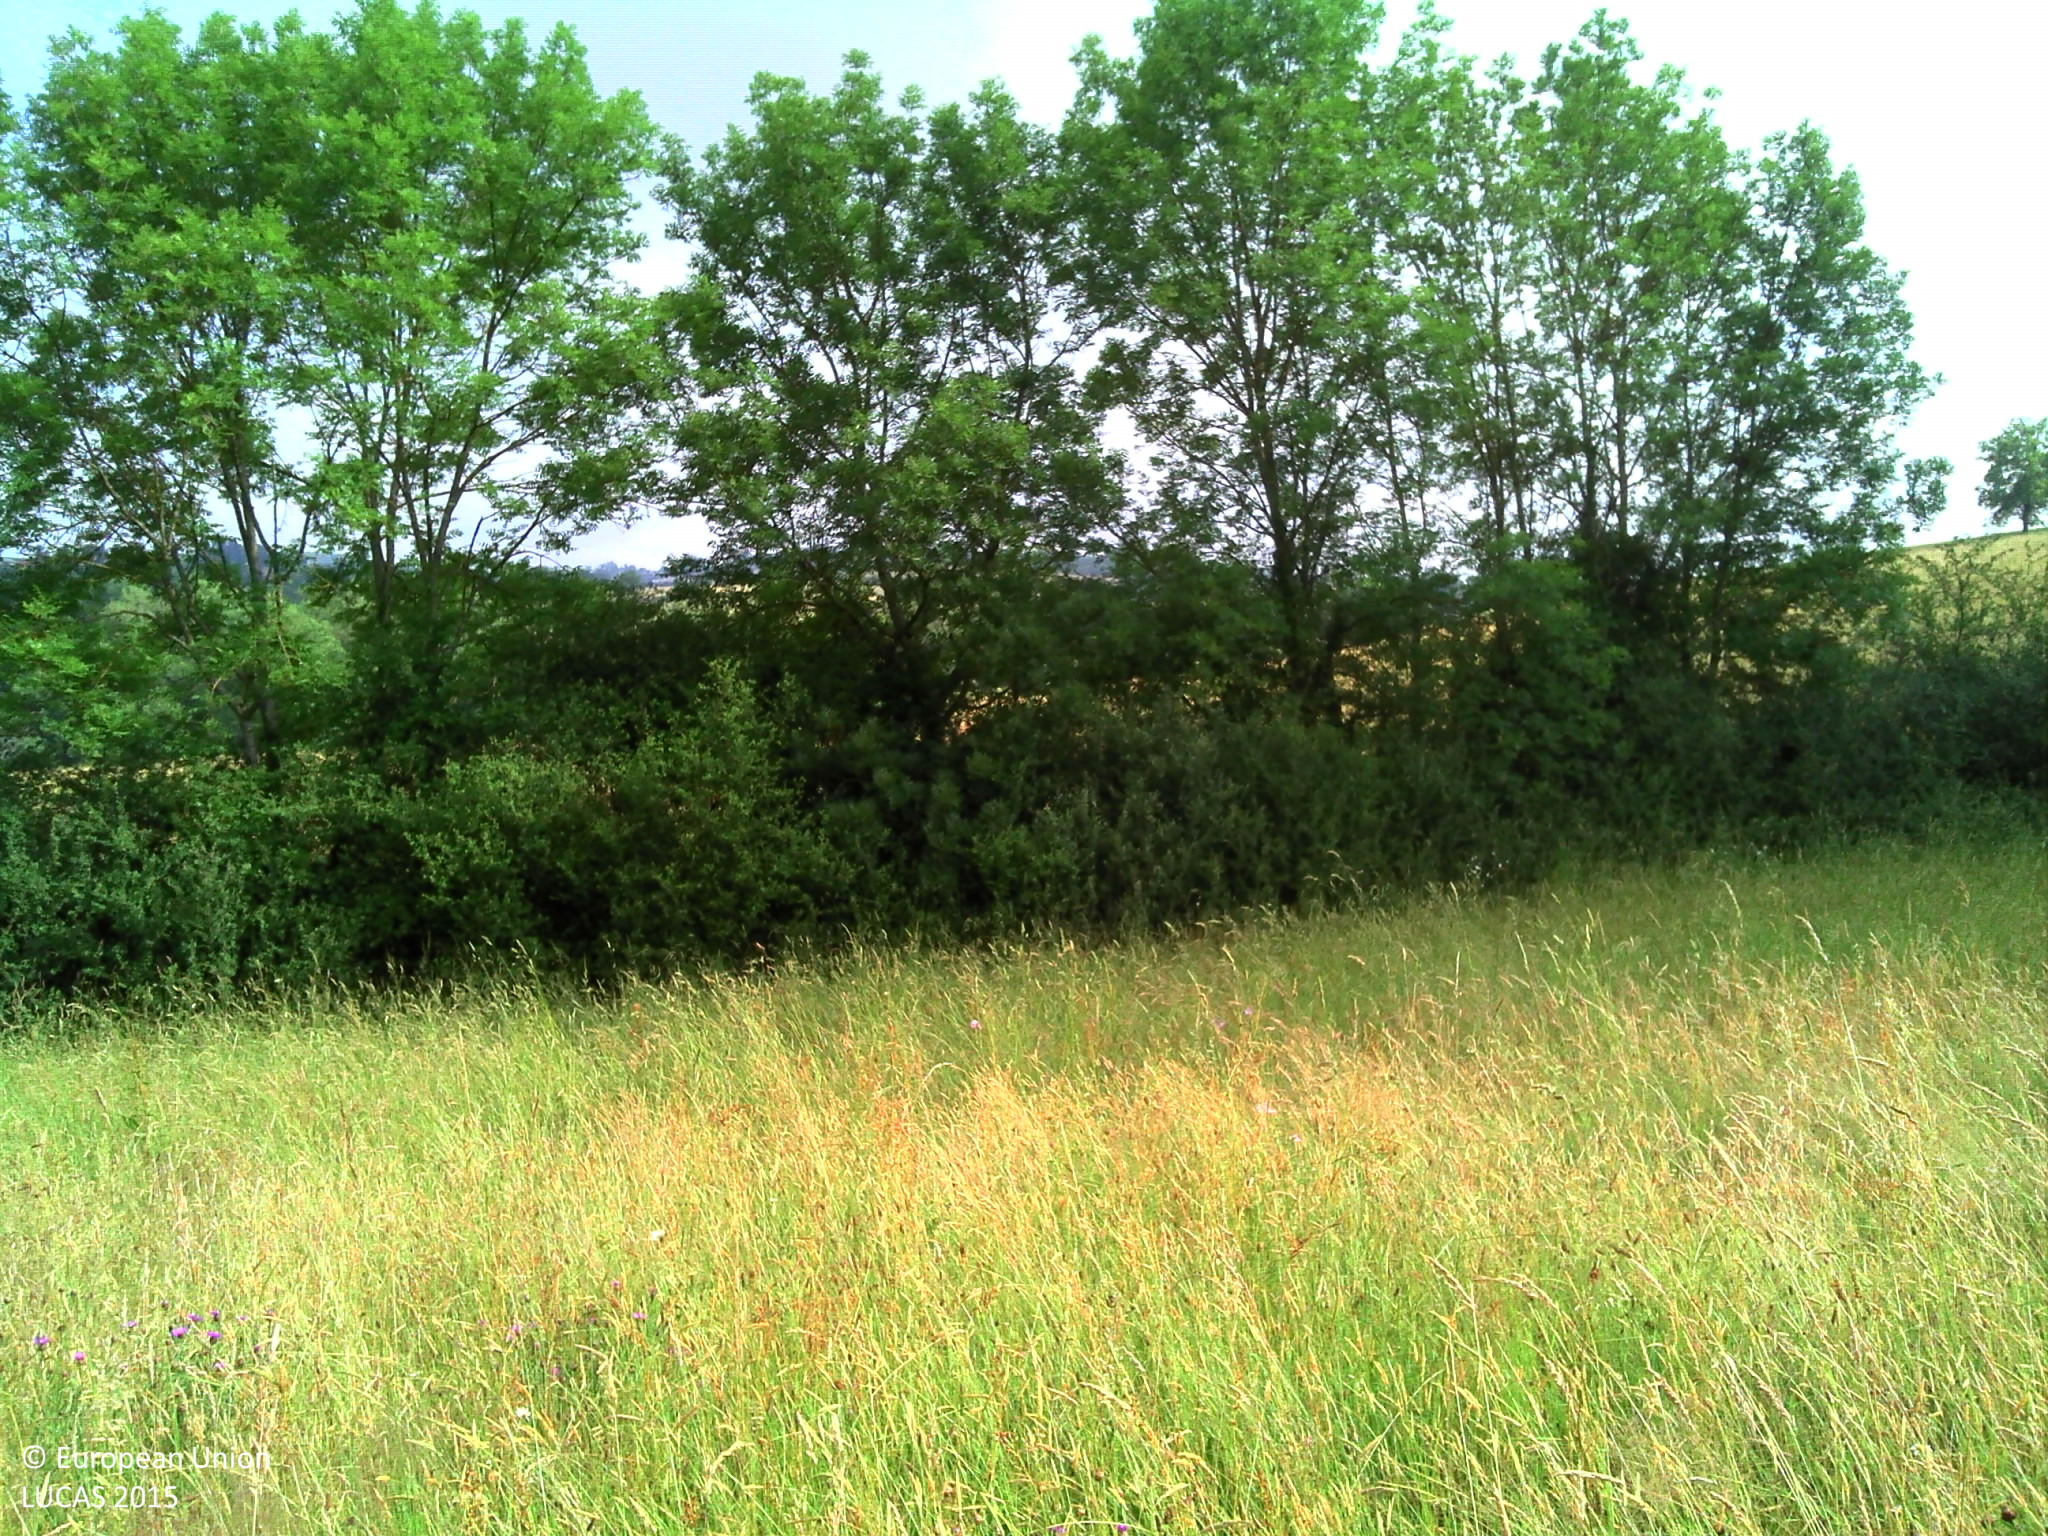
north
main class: Grassland
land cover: Grassland without tree/shrub cover
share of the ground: > 75 %
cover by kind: herbaceous plants 100 %
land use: Agriculture (excluding fallow land and kitchen gardens)
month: June
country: FR
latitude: 44.2087
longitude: 2.0552
